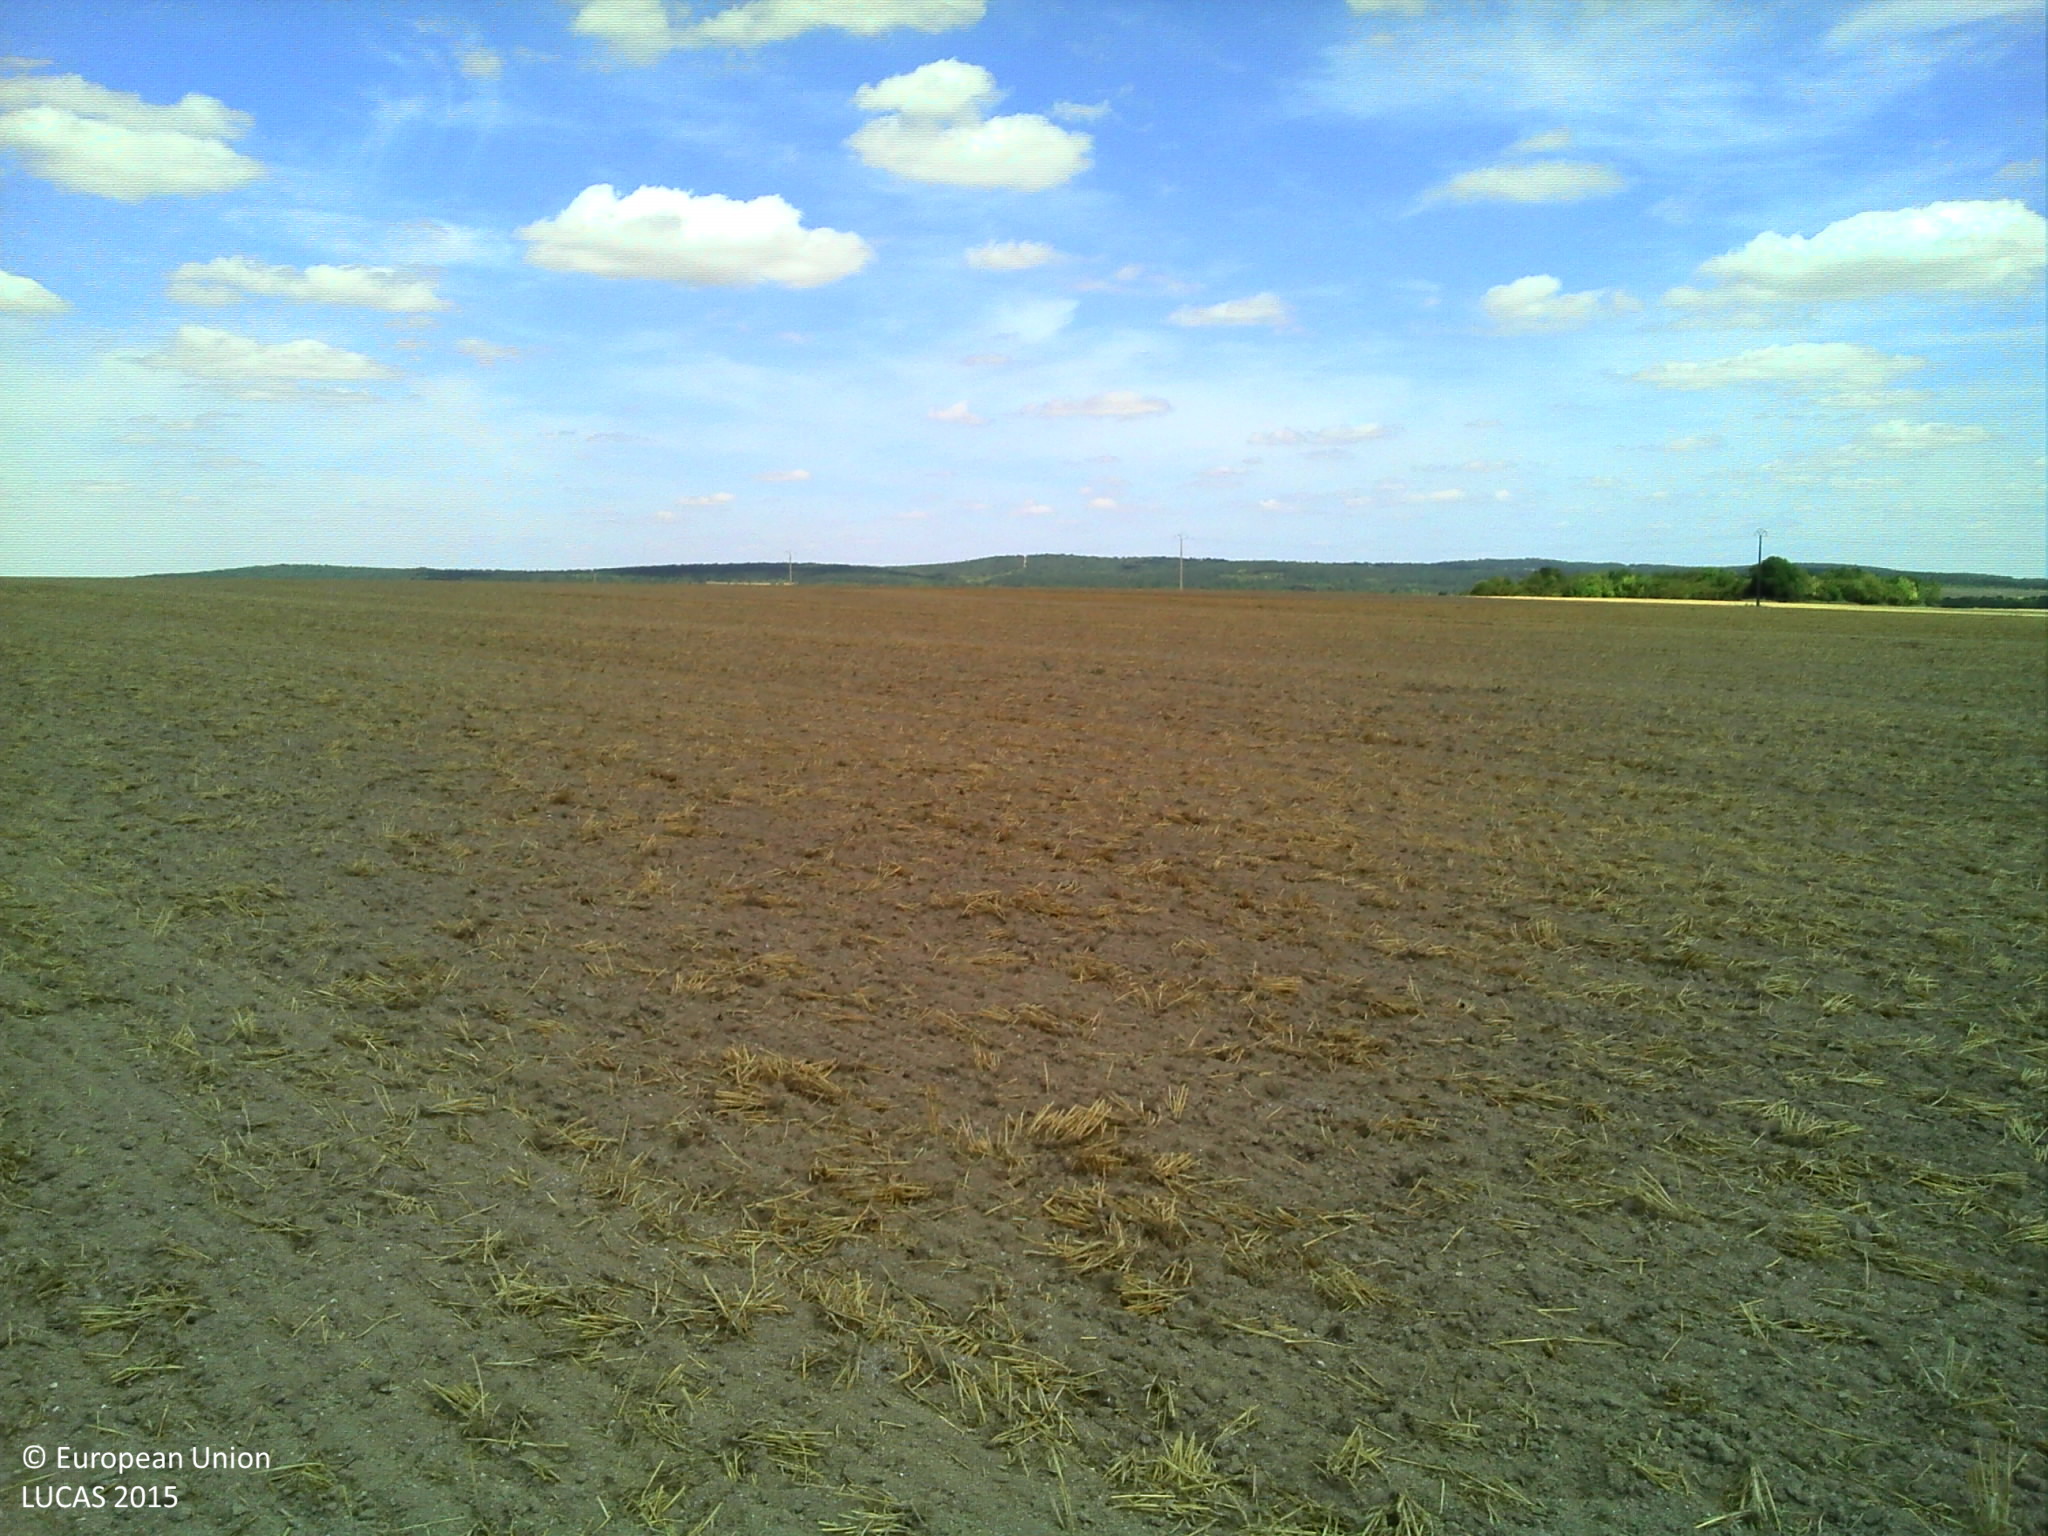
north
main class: Cropland
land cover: Barley
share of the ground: > 75 %
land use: Agriculture (excluding fallow land and kitchen gardens)
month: August
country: FR
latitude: 49.1764
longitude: 4.3032
